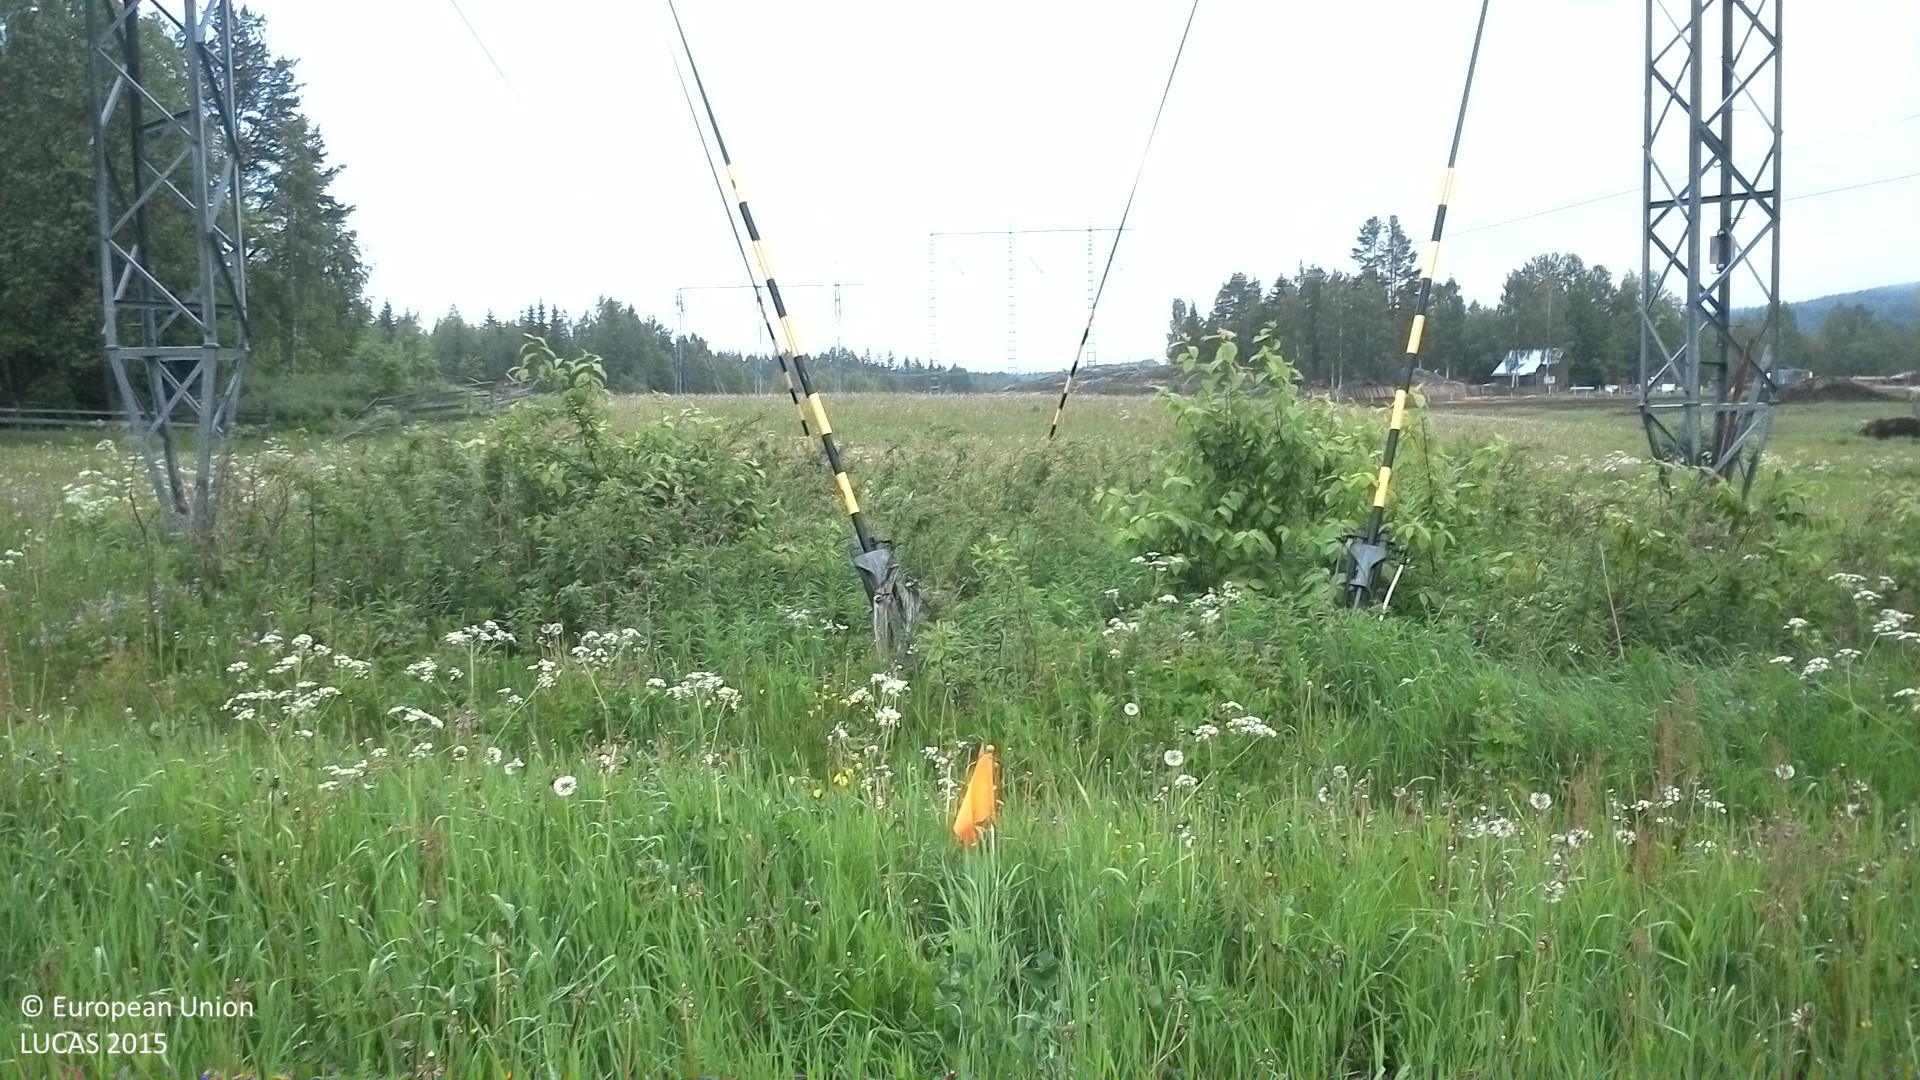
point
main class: Artificial land
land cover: Other artificial areas
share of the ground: > 75 %
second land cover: Other leguminous and mixtures for fodder
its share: > 75 %
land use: Electricity, gas and thermal power distribution
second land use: Agriculture (excluding fallow land and kitchen gardens)
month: June
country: SE
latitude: 62.0189
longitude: 16.9173
